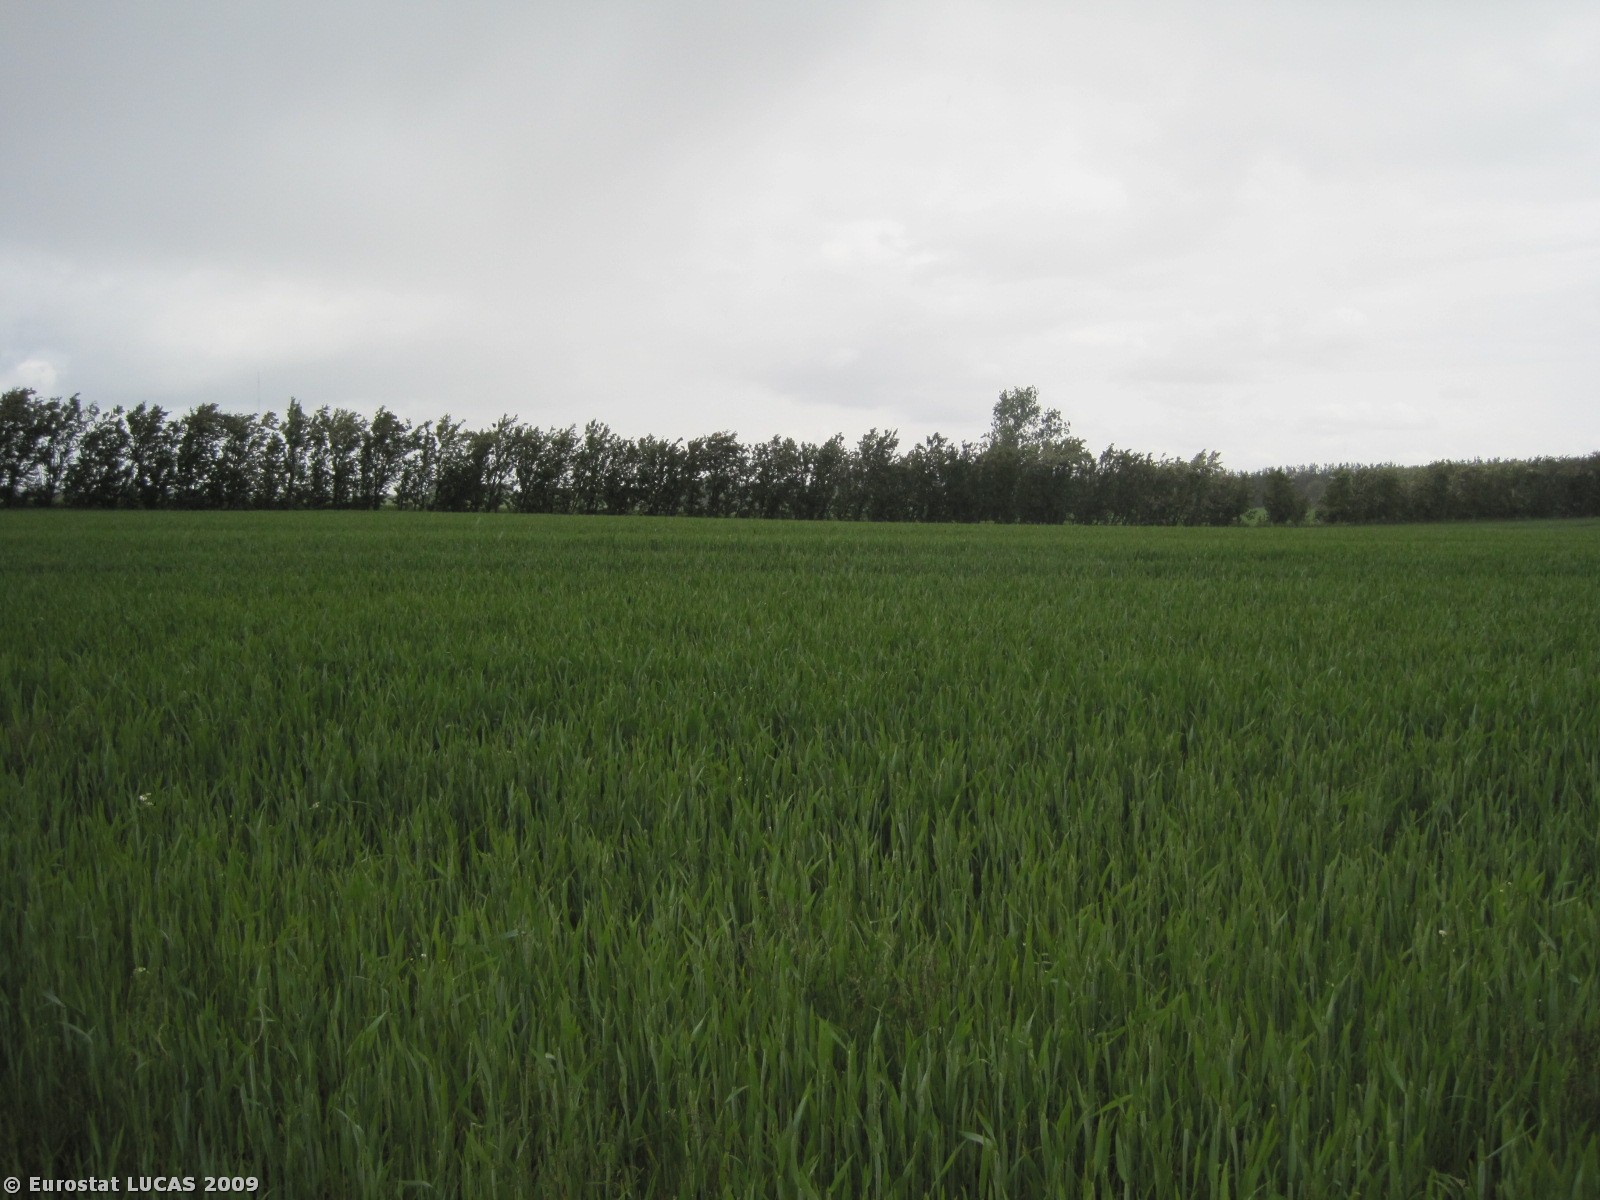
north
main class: Cropland
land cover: Common wheat
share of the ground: > 75 %
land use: Agriculture (excluding fallow land and kitchen gardens)
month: June
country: DK
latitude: 56.9426
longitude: 9.7866
